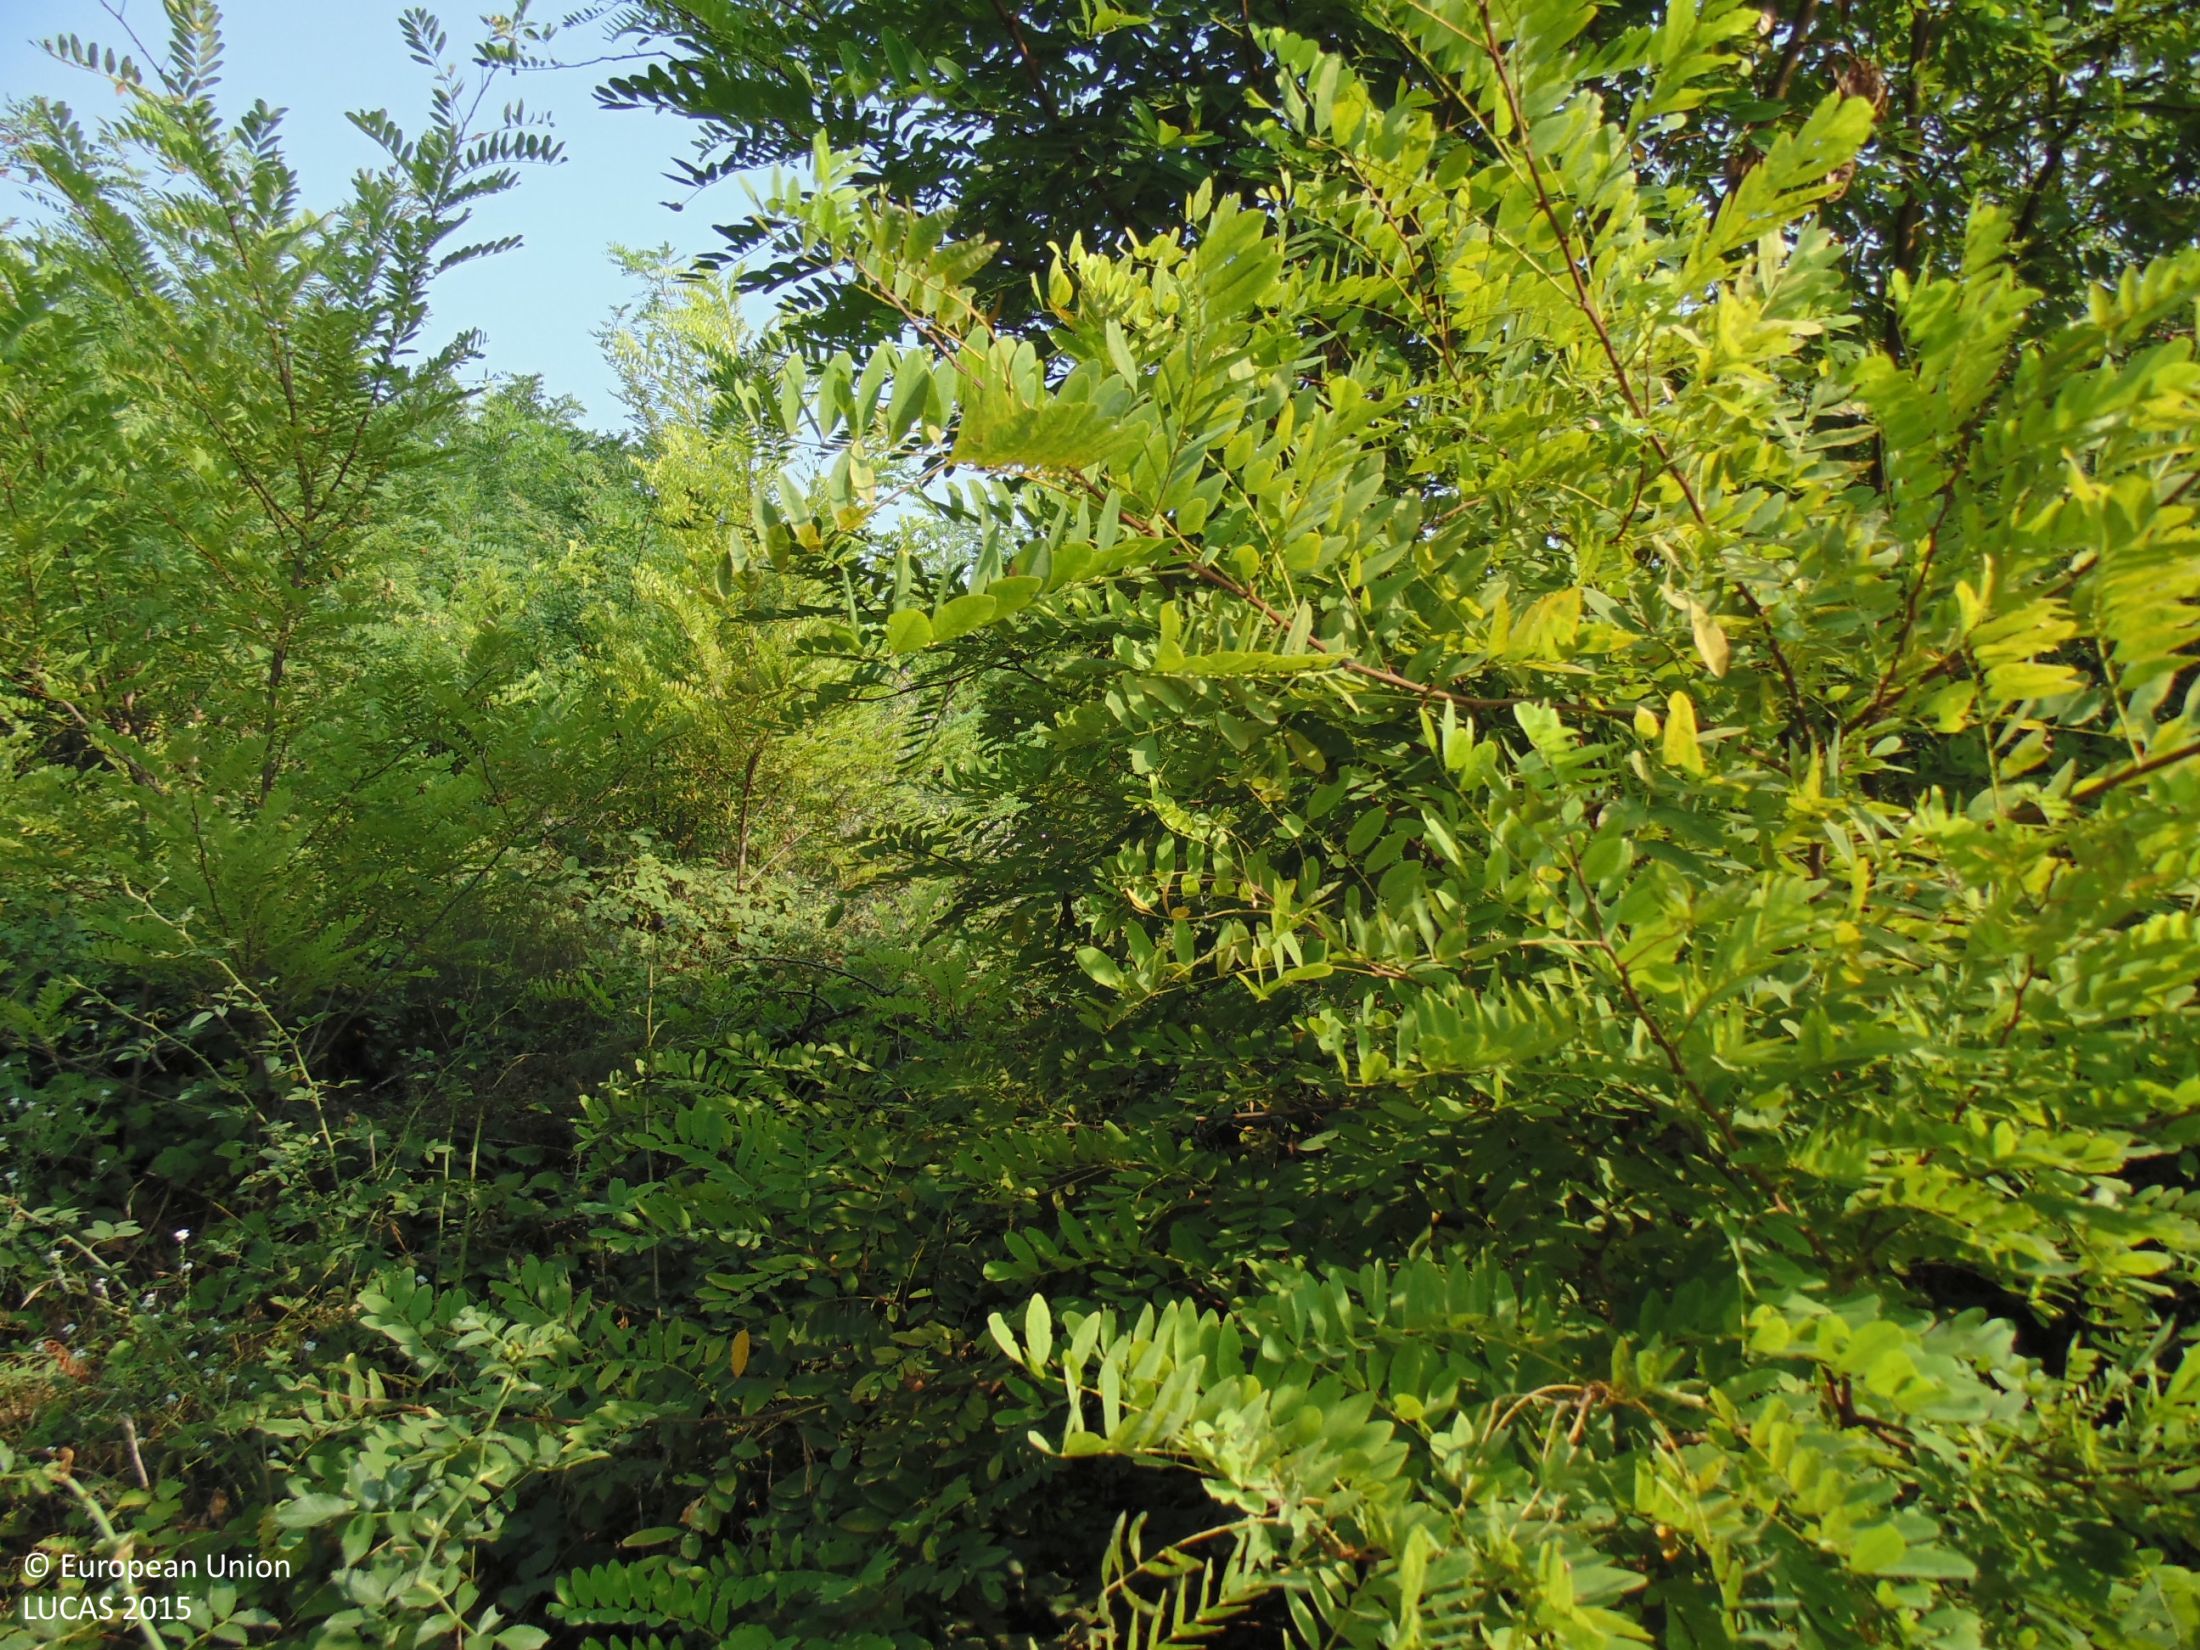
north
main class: Woodland
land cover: Broadleaved woodland
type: mesophytic deciduous forest
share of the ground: > 75 %
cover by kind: broadleaved forest trees 85 %, unconsolidated bare surface 10 %, shrubs 5 %
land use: Forestry
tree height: > 5 m
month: August
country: BG
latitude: 44.0112
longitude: 27.3845
